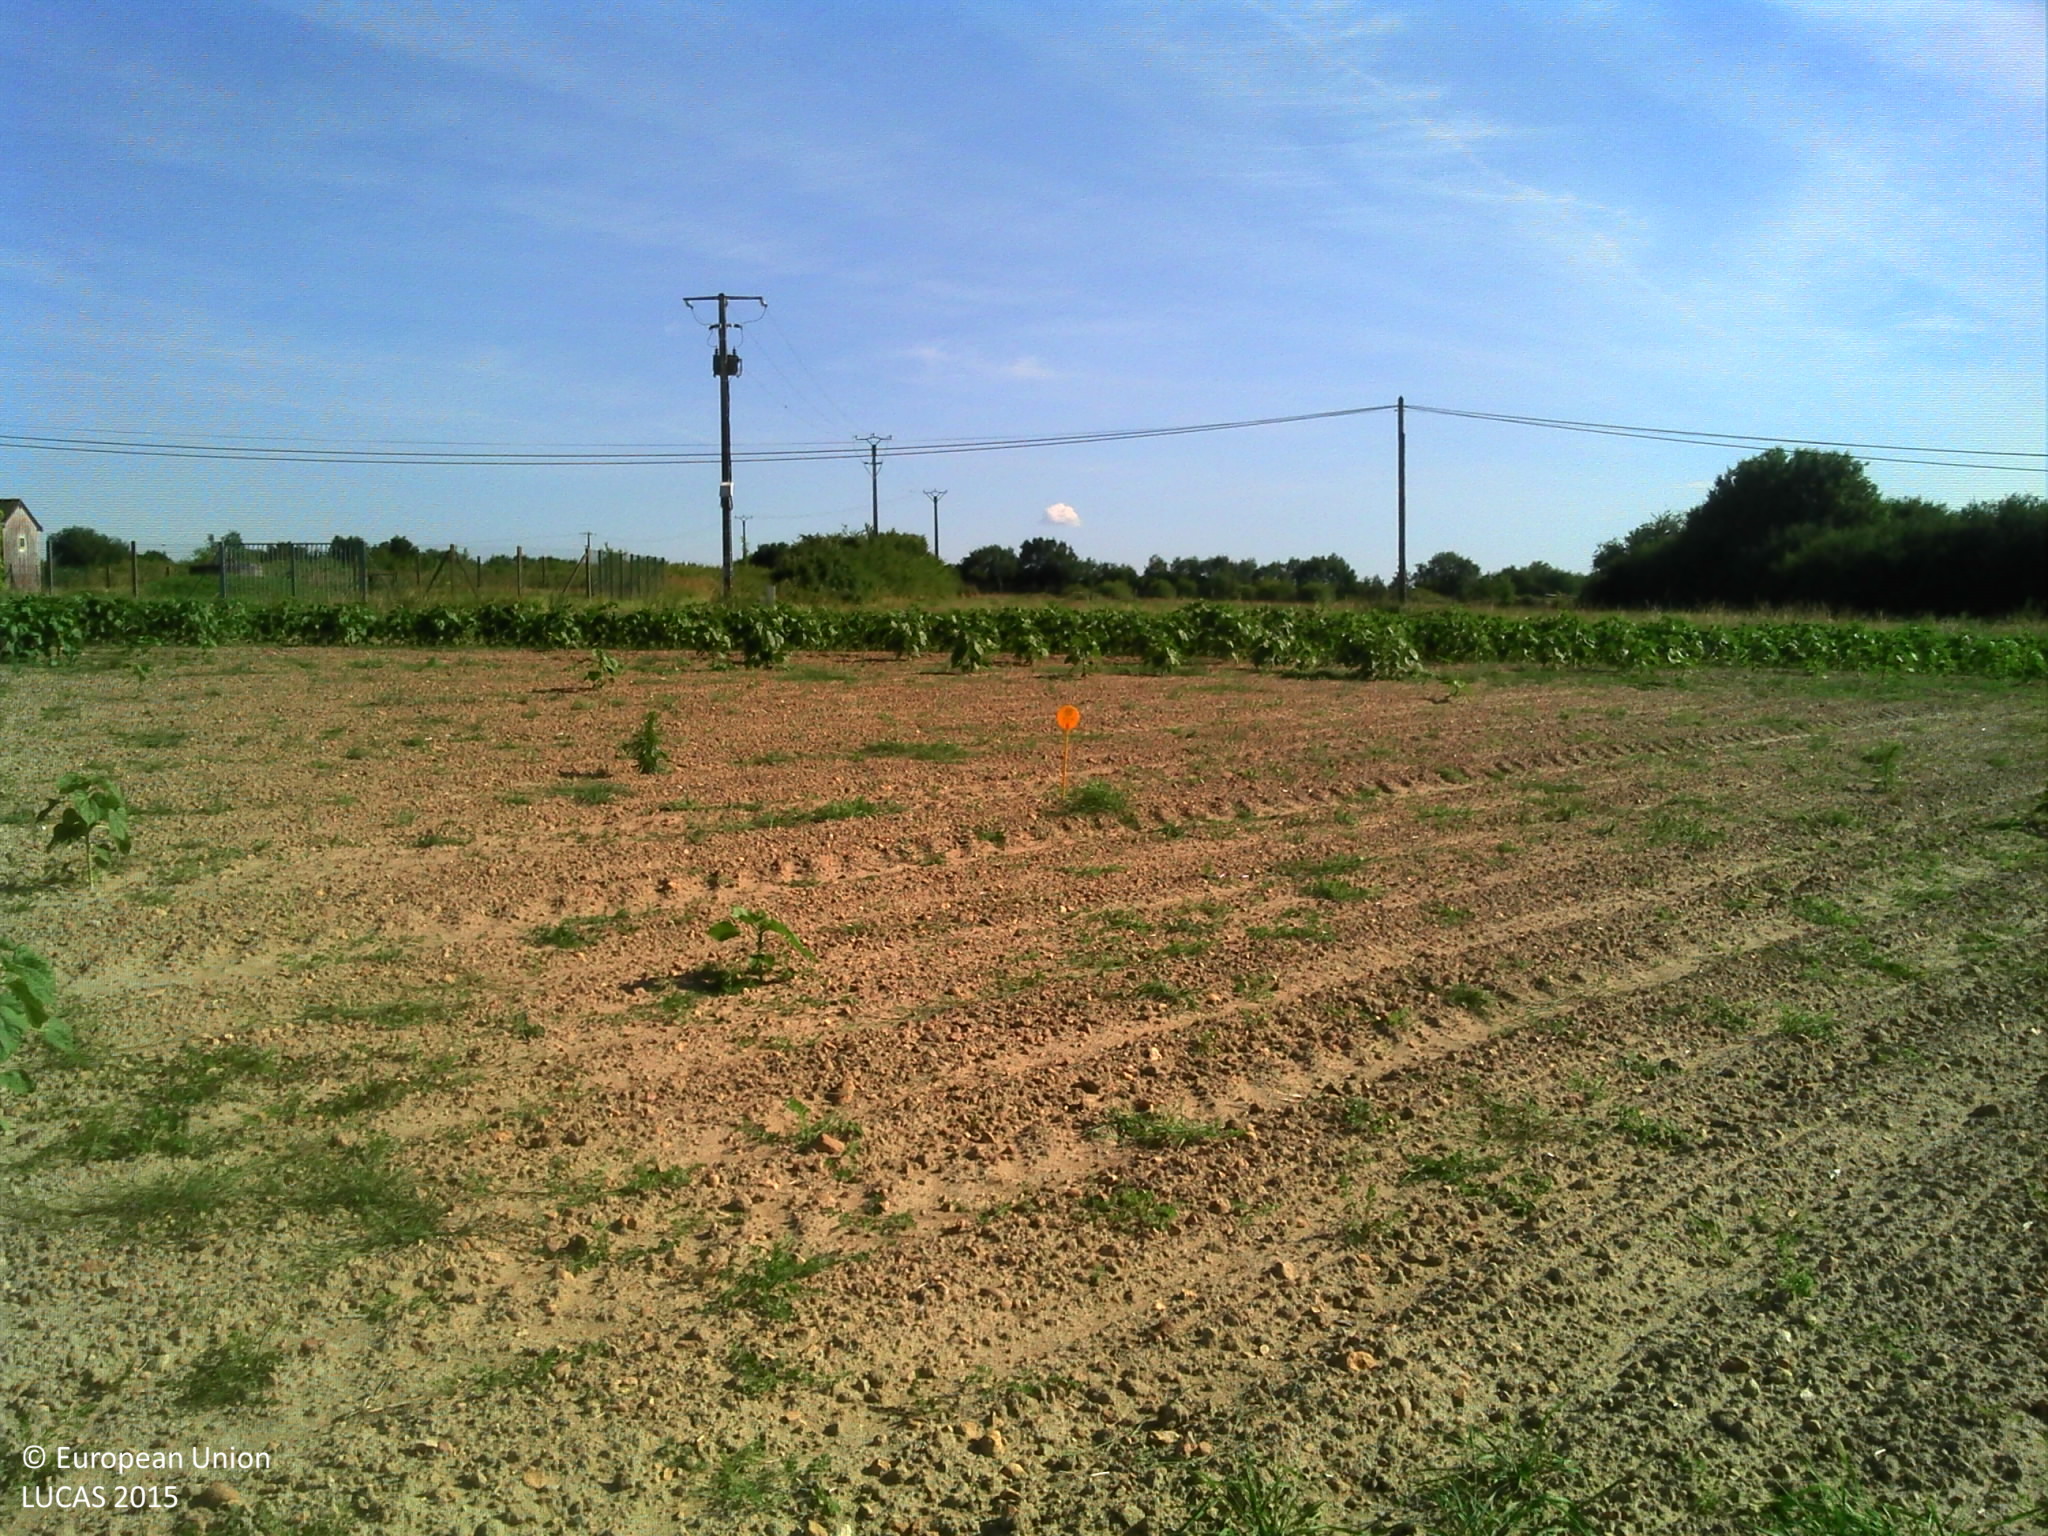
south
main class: Cropland
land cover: Sunflower
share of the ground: 10 - 25 %
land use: Agriculture (excluding fallow land and kitchen gardens)
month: June
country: FR
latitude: 47.5558
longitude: 0.2618
